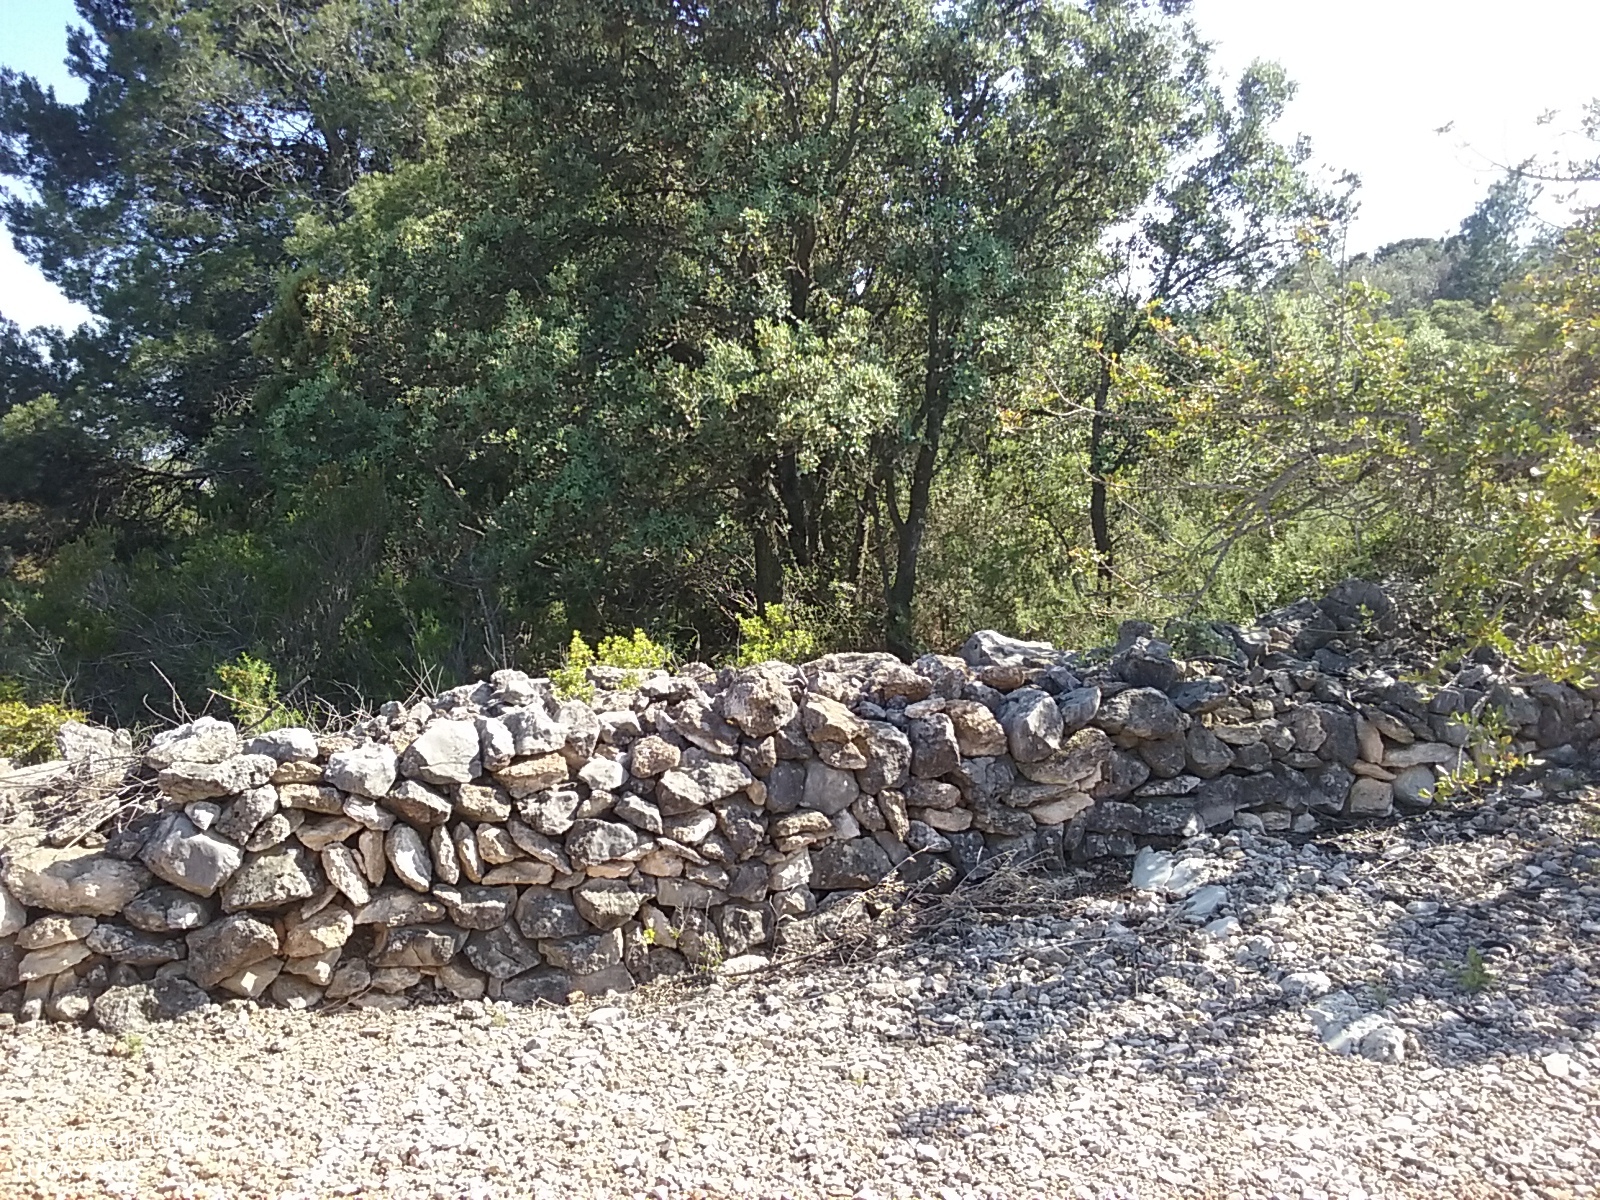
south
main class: Cropland
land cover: Olive groves
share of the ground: 25 - 50 %
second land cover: Other bare soil
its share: > 75 %
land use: Agriculture (excluding fallow land and kitchen gardens)
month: May
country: ES
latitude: 40.5995
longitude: 0.2453
